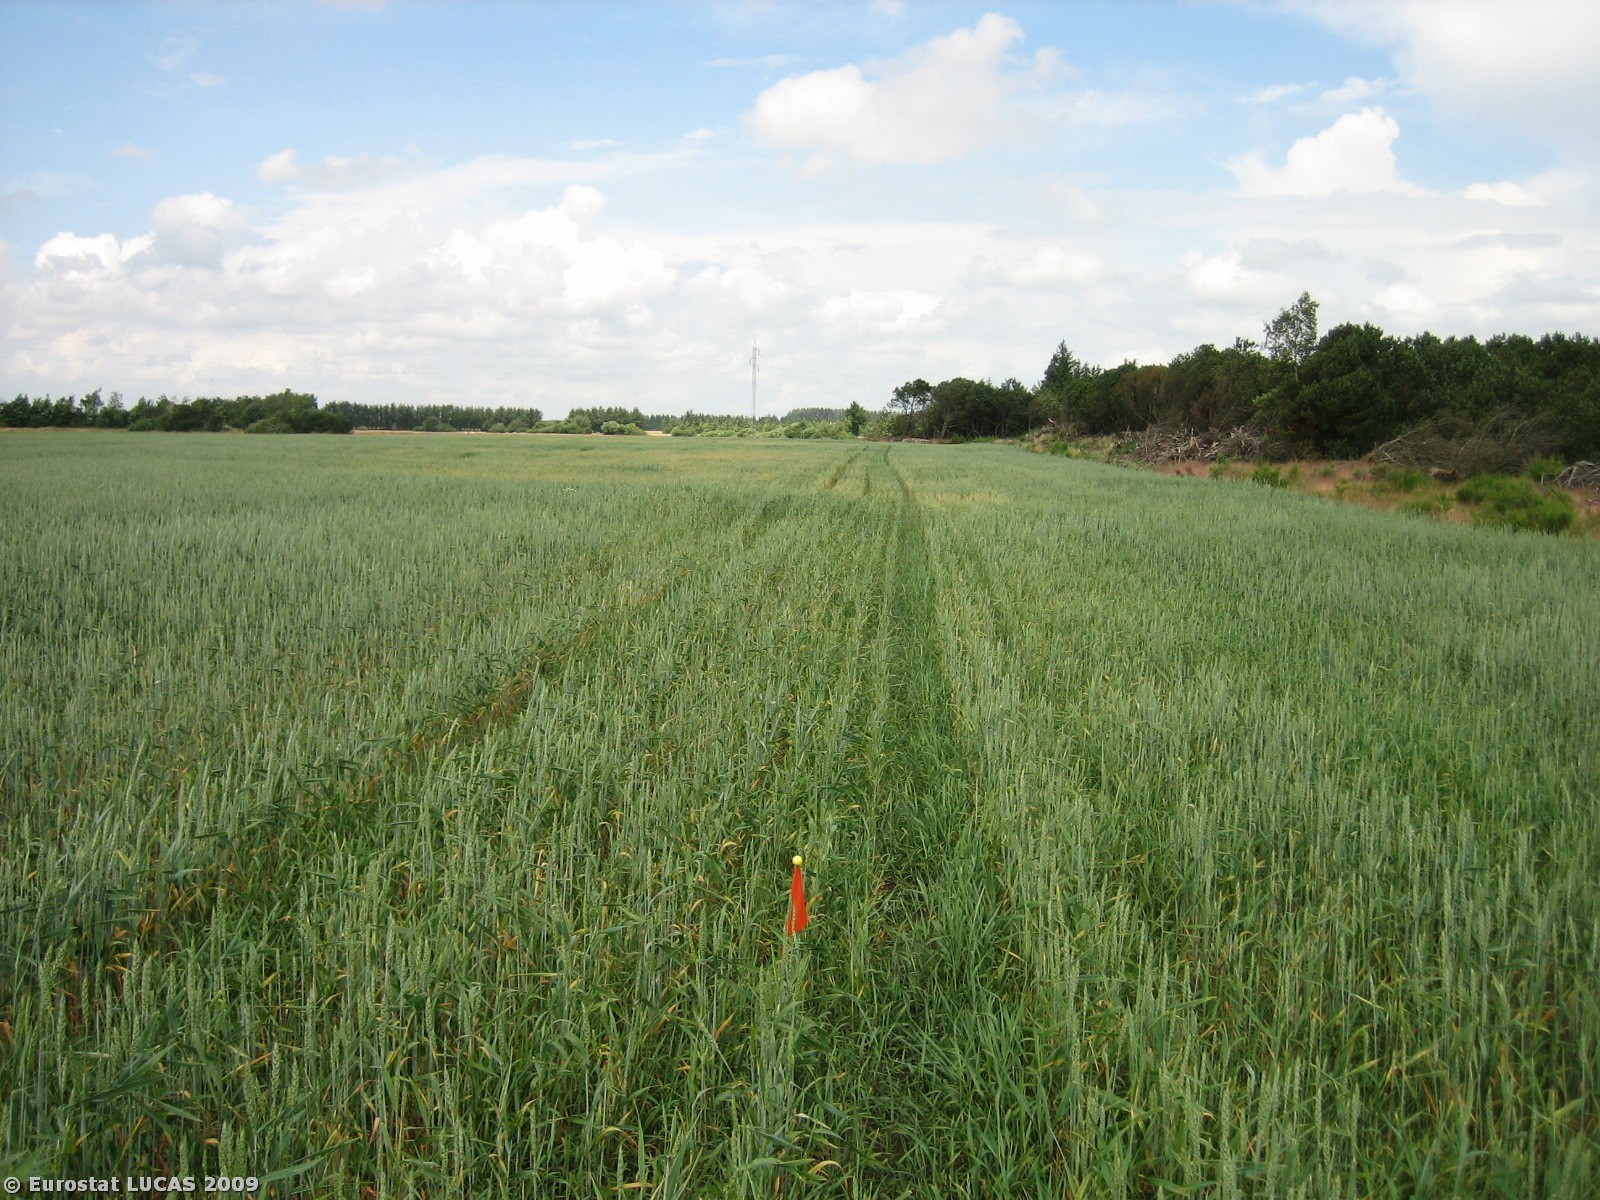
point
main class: Cropland
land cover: Triticale
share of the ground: > 75 %
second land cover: Spontaneously vegetated surfaces
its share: 50 - 75 %
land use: Agriculture (excluding fallow land and kitchen gardens)
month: July
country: DK
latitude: 55.6076
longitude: 8.8740
